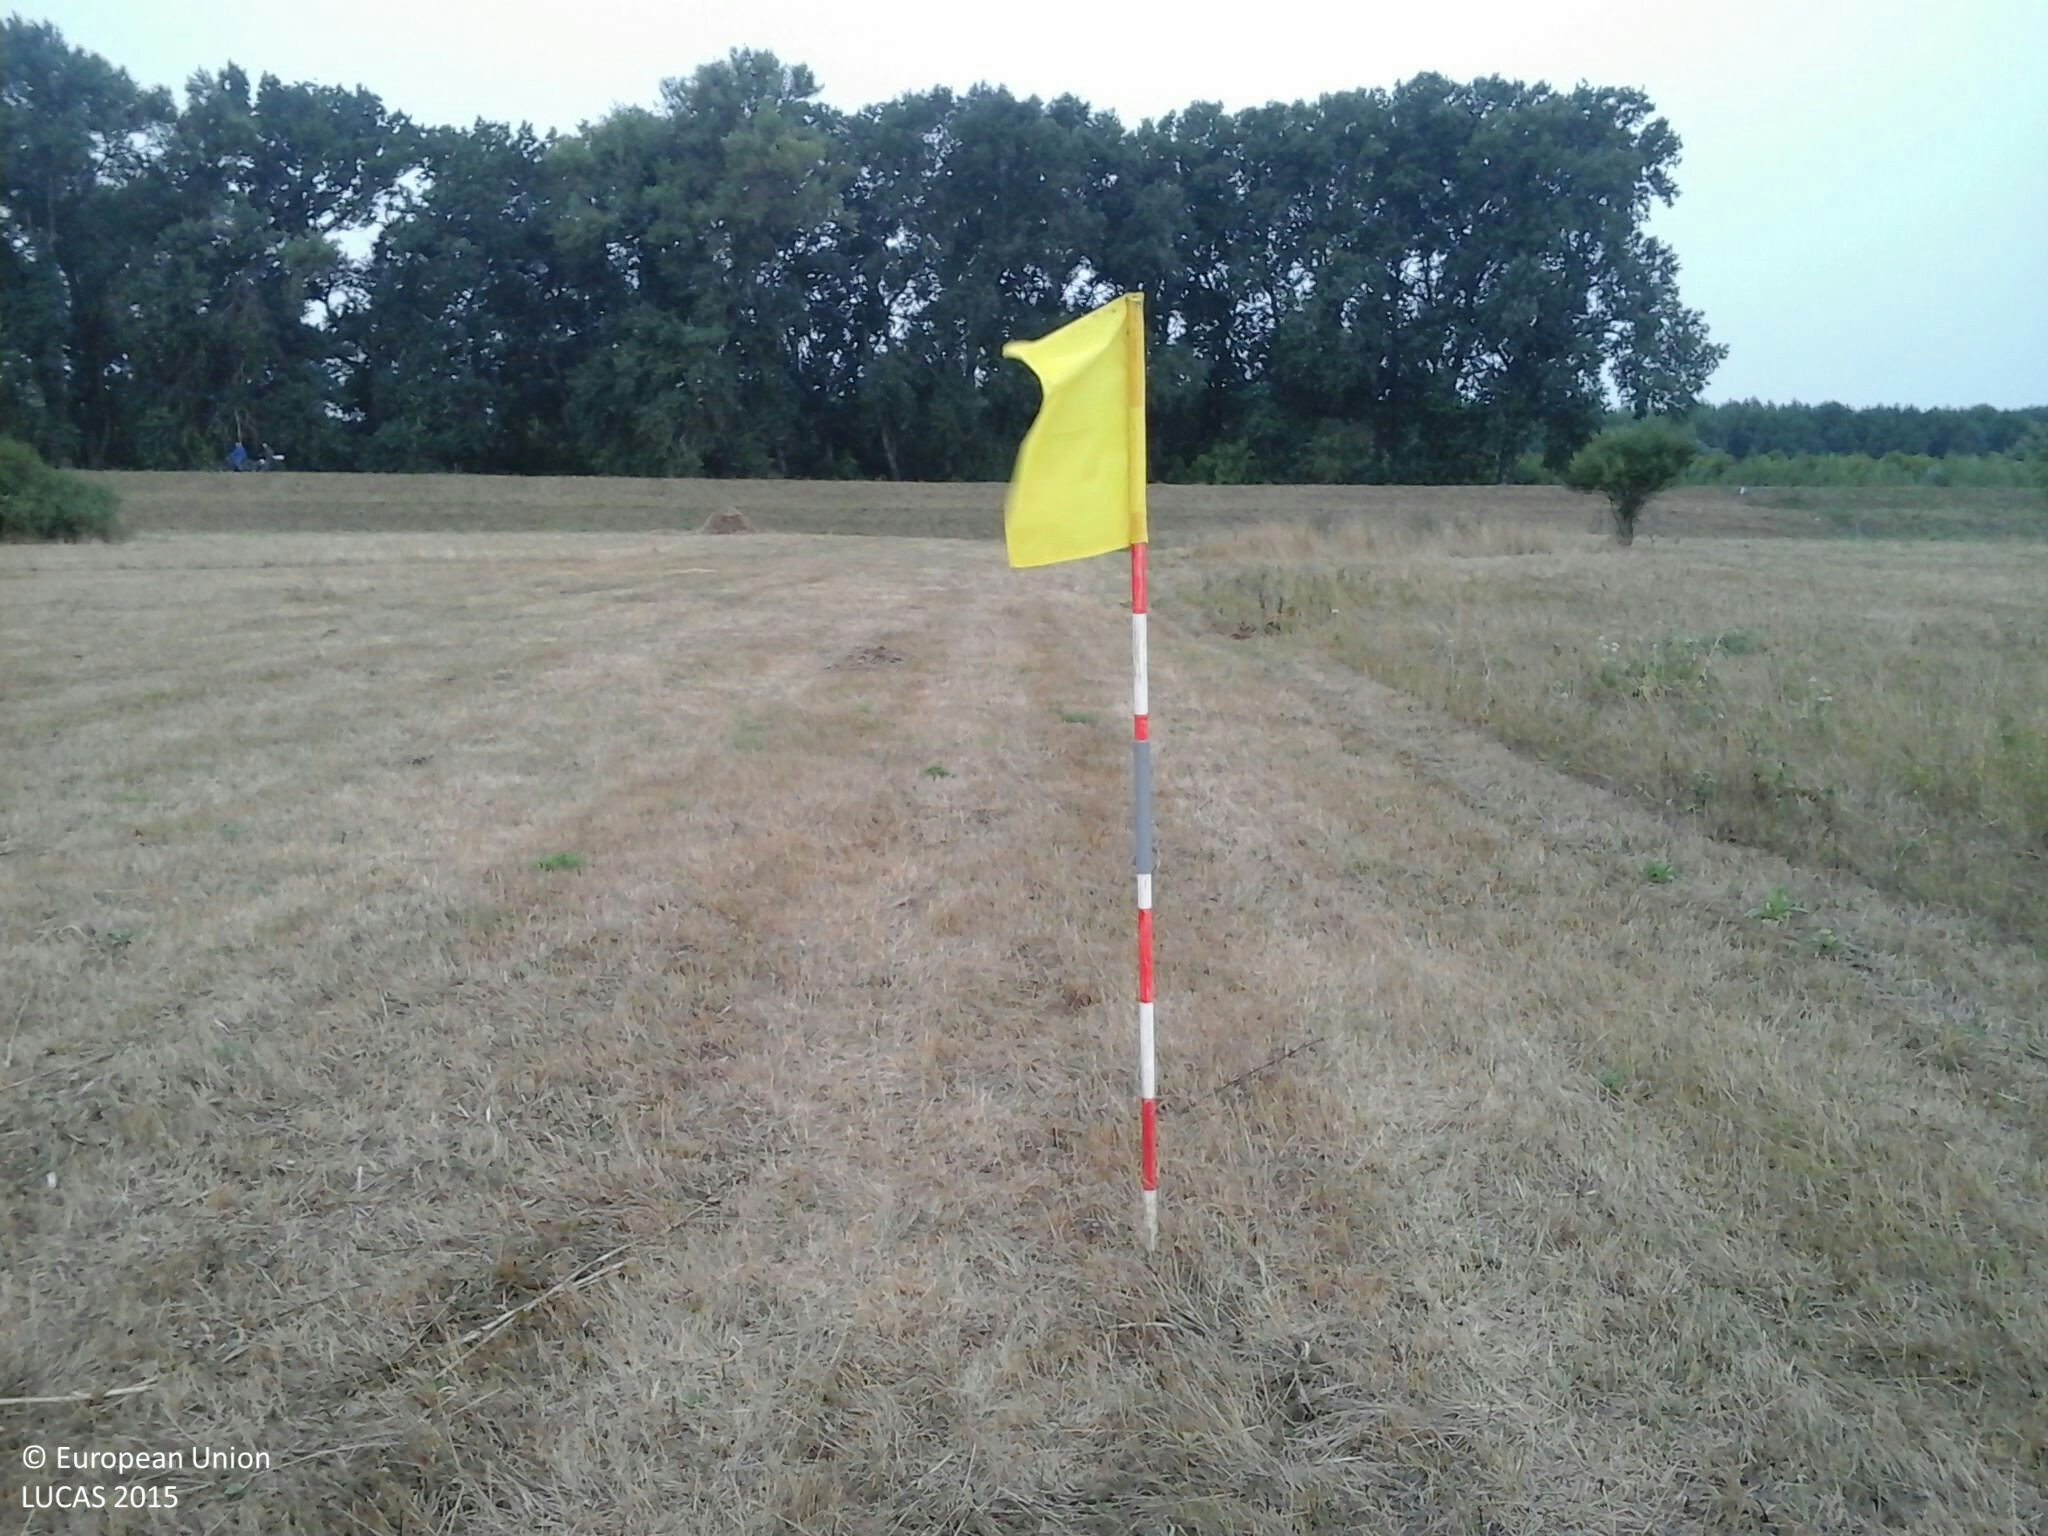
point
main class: Grassland
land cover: Grassland without tree/shrub cover
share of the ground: > 75 %
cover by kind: herbaceous plants 100 %
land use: Agriculture (excluding fallow land and kitchen gardens)
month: August
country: HU
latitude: 47.9735
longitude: 21.0642
